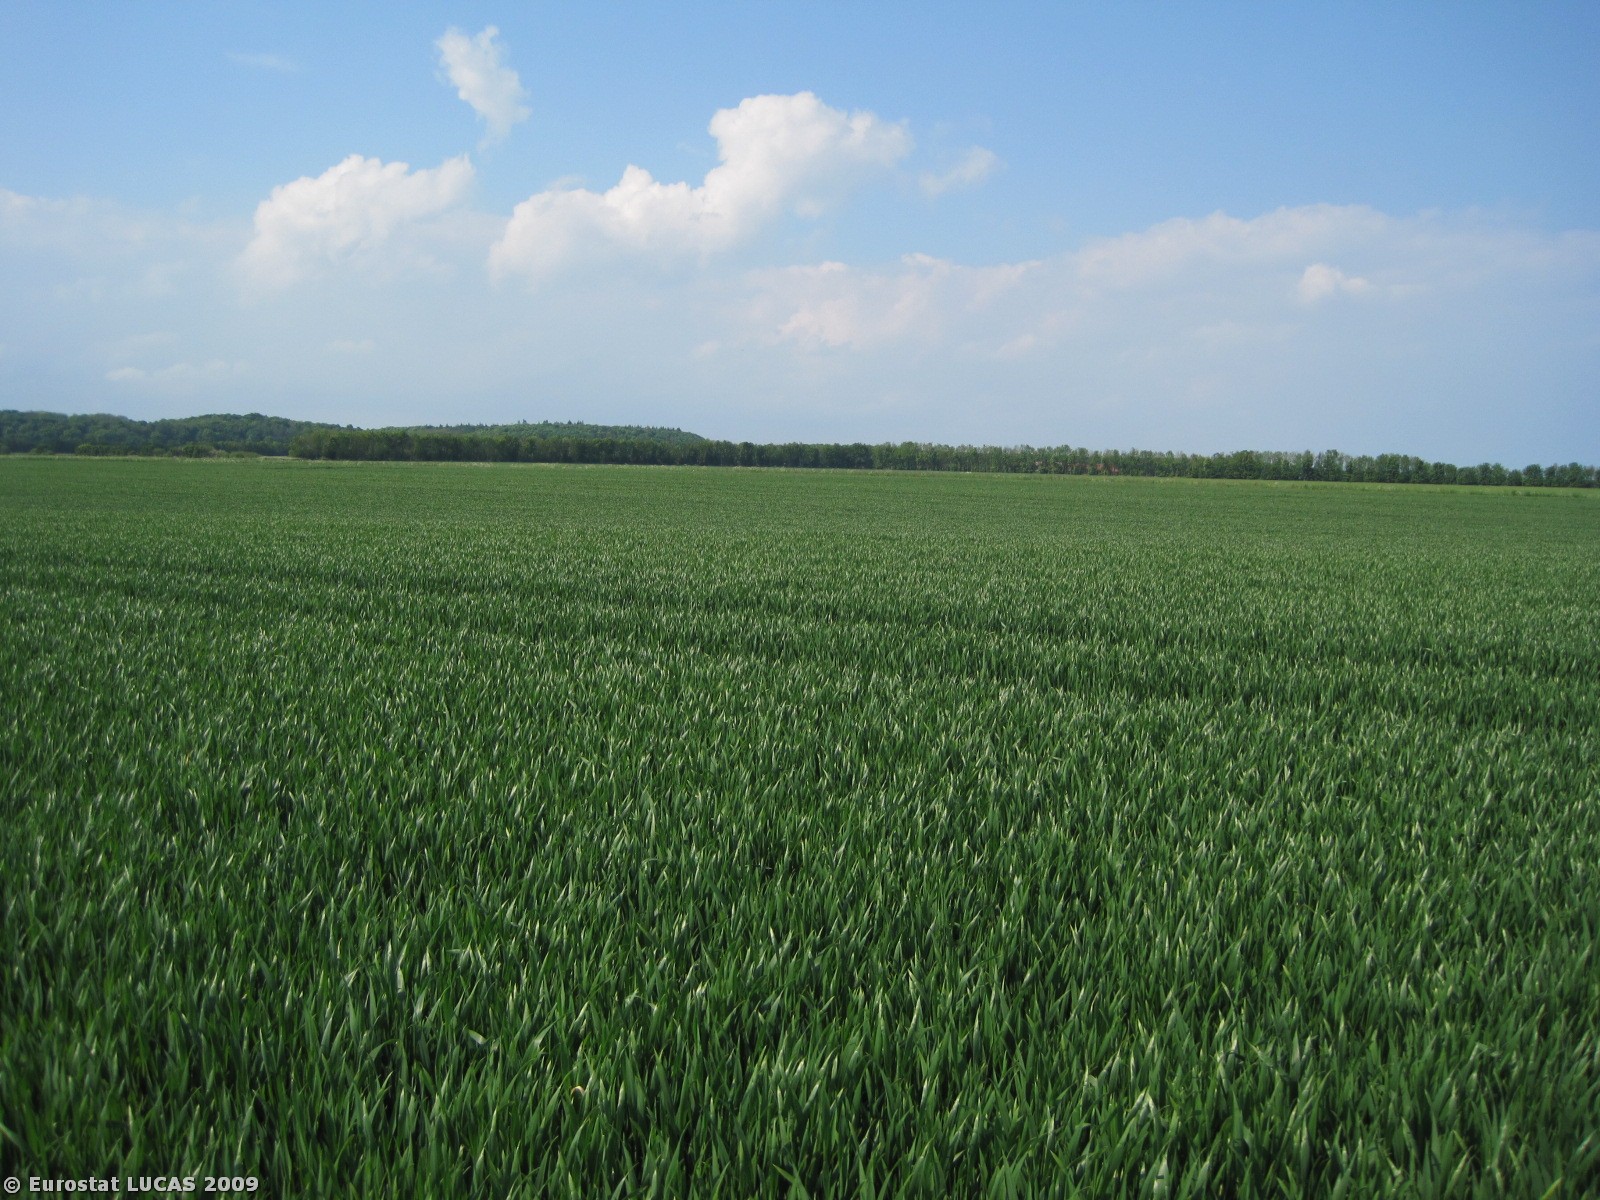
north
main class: Cropland
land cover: Common wheat
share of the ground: > 75 %
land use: Agriculture (excluding fallow land and kitchen gardens)
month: May
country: DK
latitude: 56.6728
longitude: 10.2770
